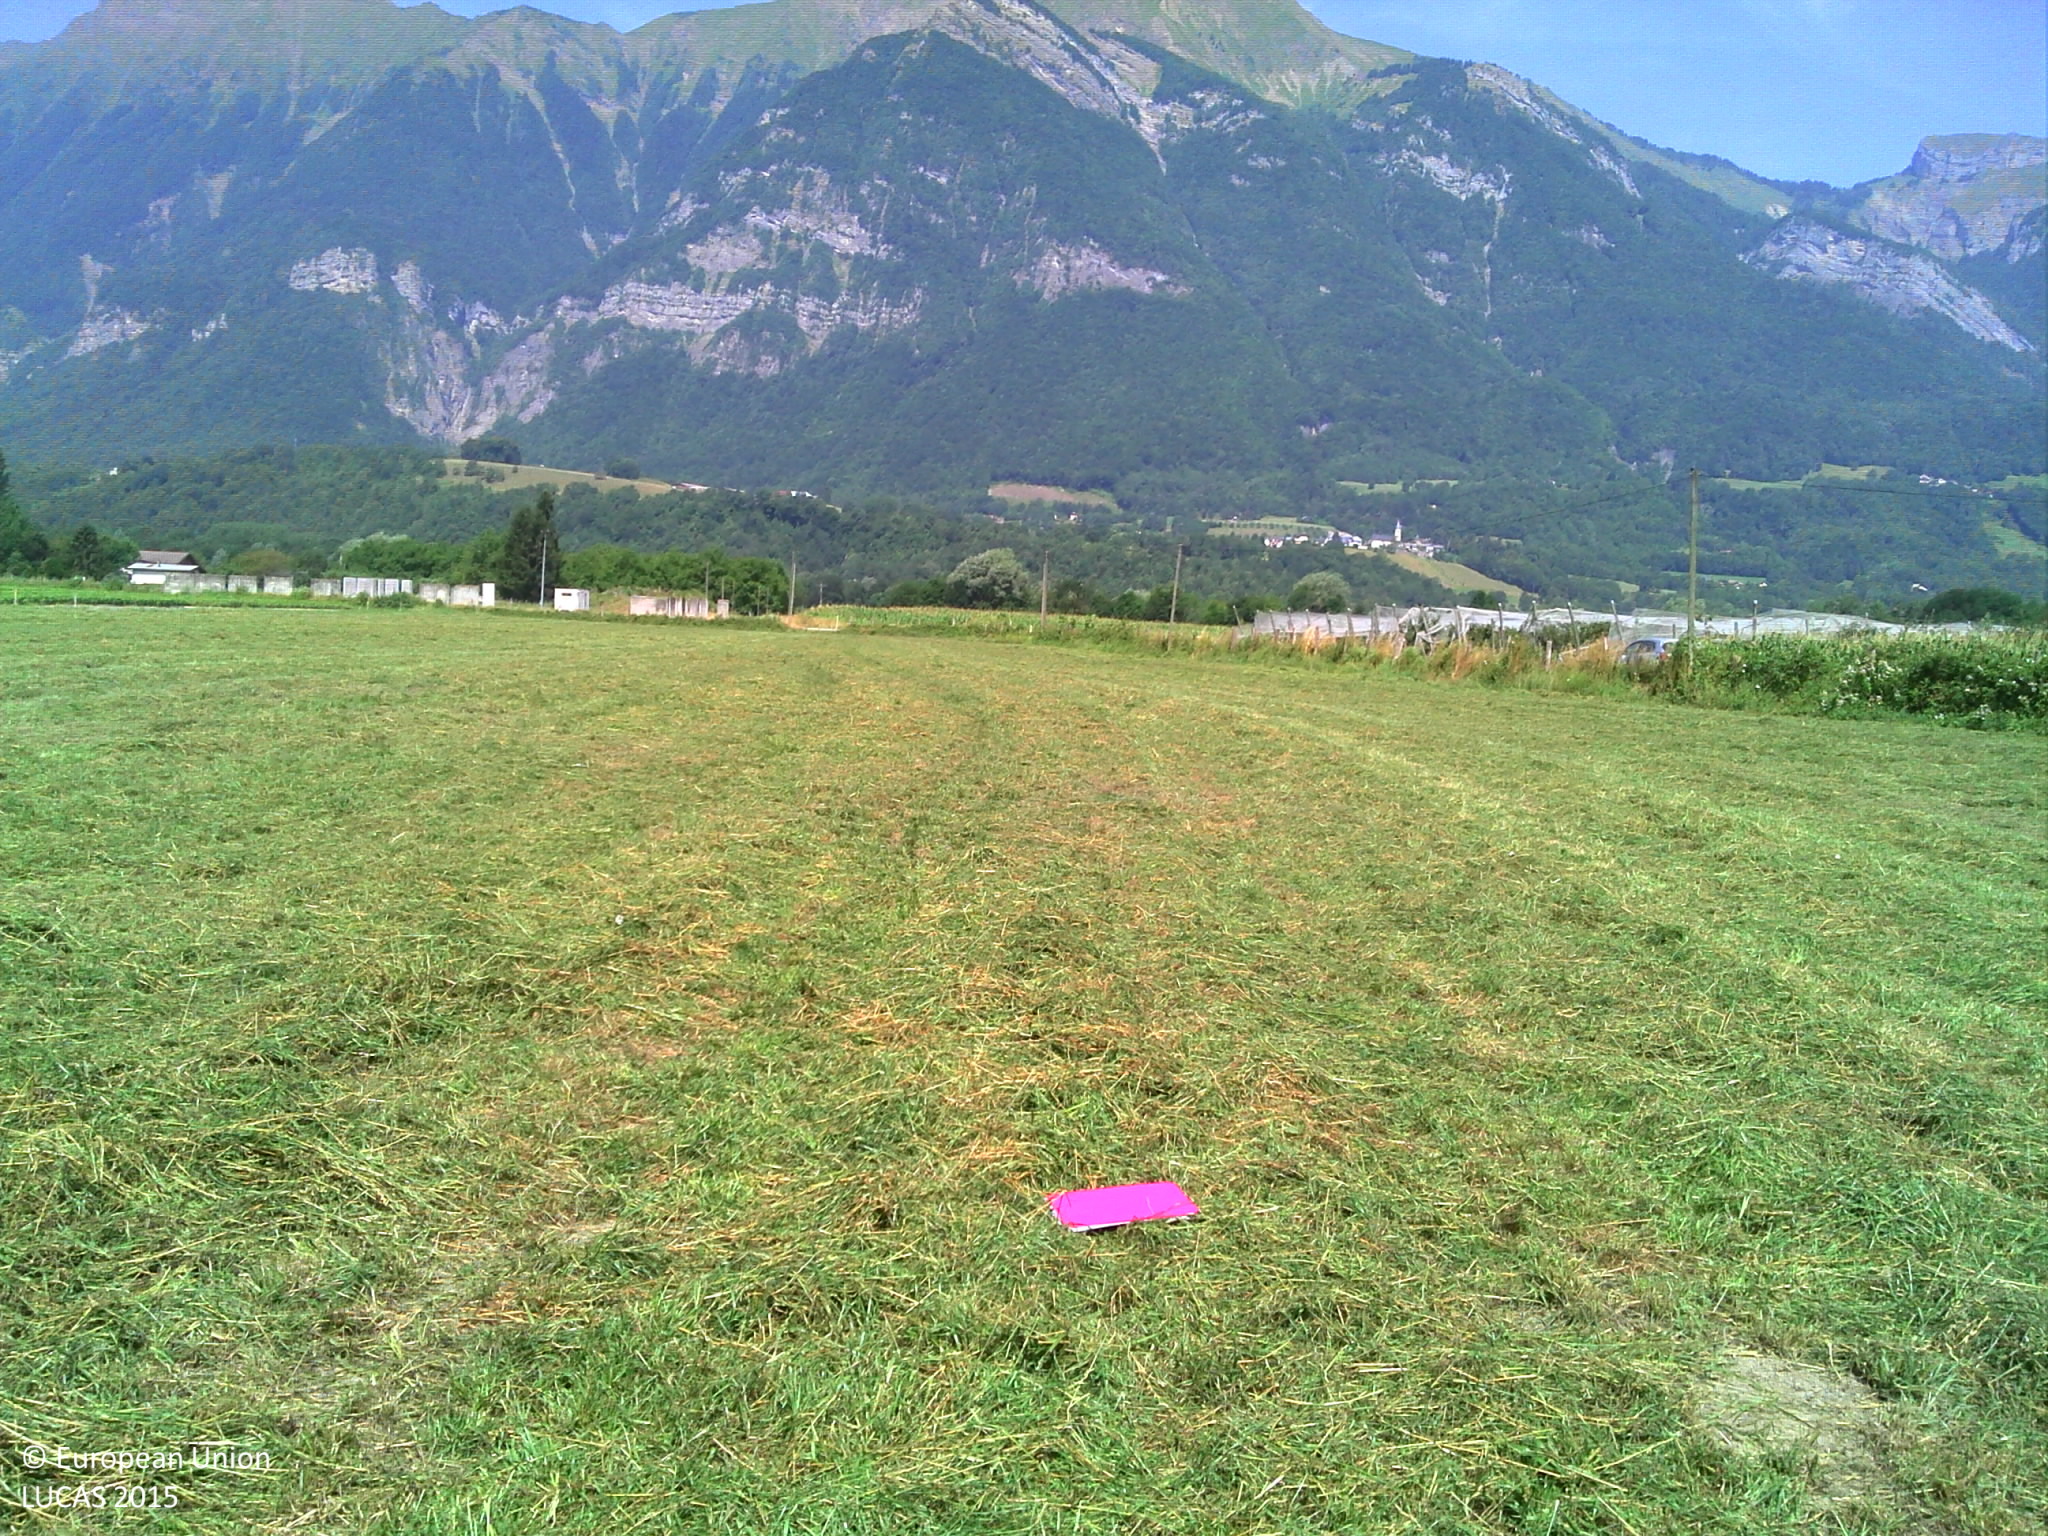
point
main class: Grassland
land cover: Grassland without tree/shrub cover
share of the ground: > 75 %
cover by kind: herbaceous plants 100 %
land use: Agriculture (excluding fallow land and kitchen gardens)
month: July
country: FR
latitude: 45.6019
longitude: 6.2993
